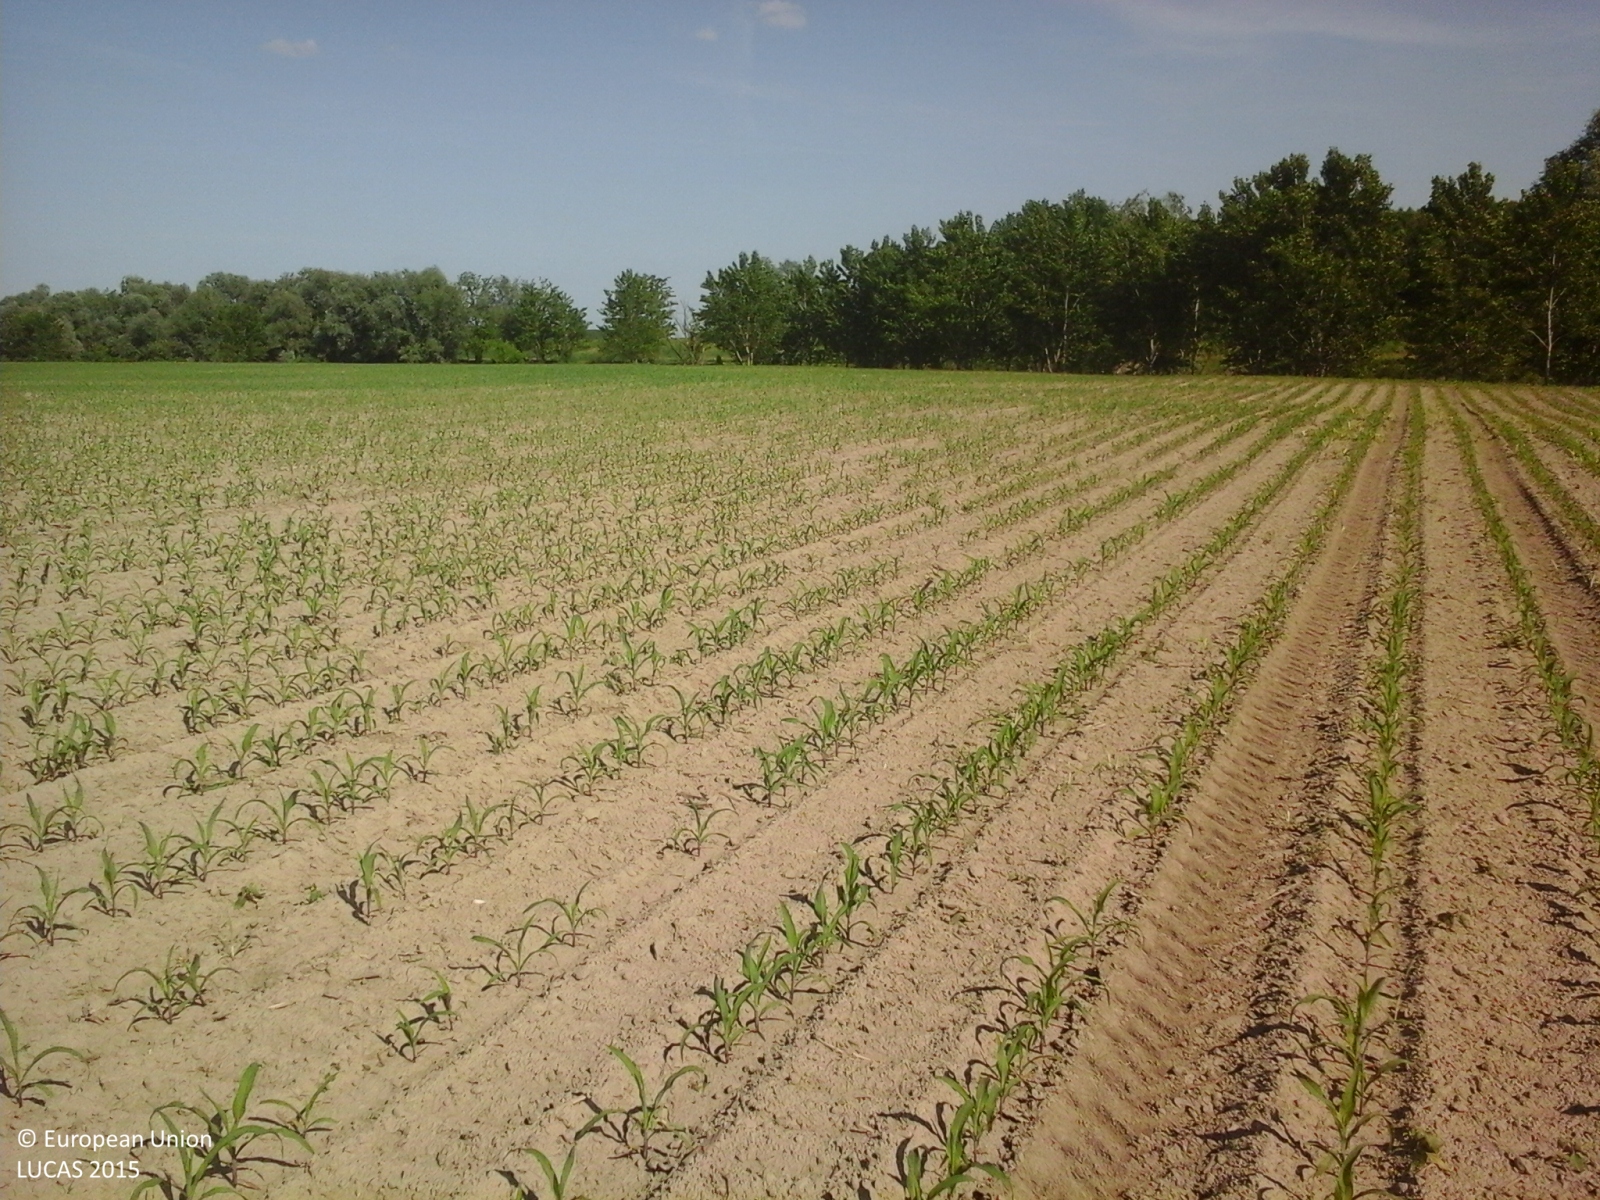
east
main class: Cropland
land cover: Maize
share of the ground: < 10 %
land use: Agriculture (excluding fallow land and kitchen gardens)
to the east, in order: Maize
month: May
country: IT
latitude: 45.0501
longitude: 10.8744
